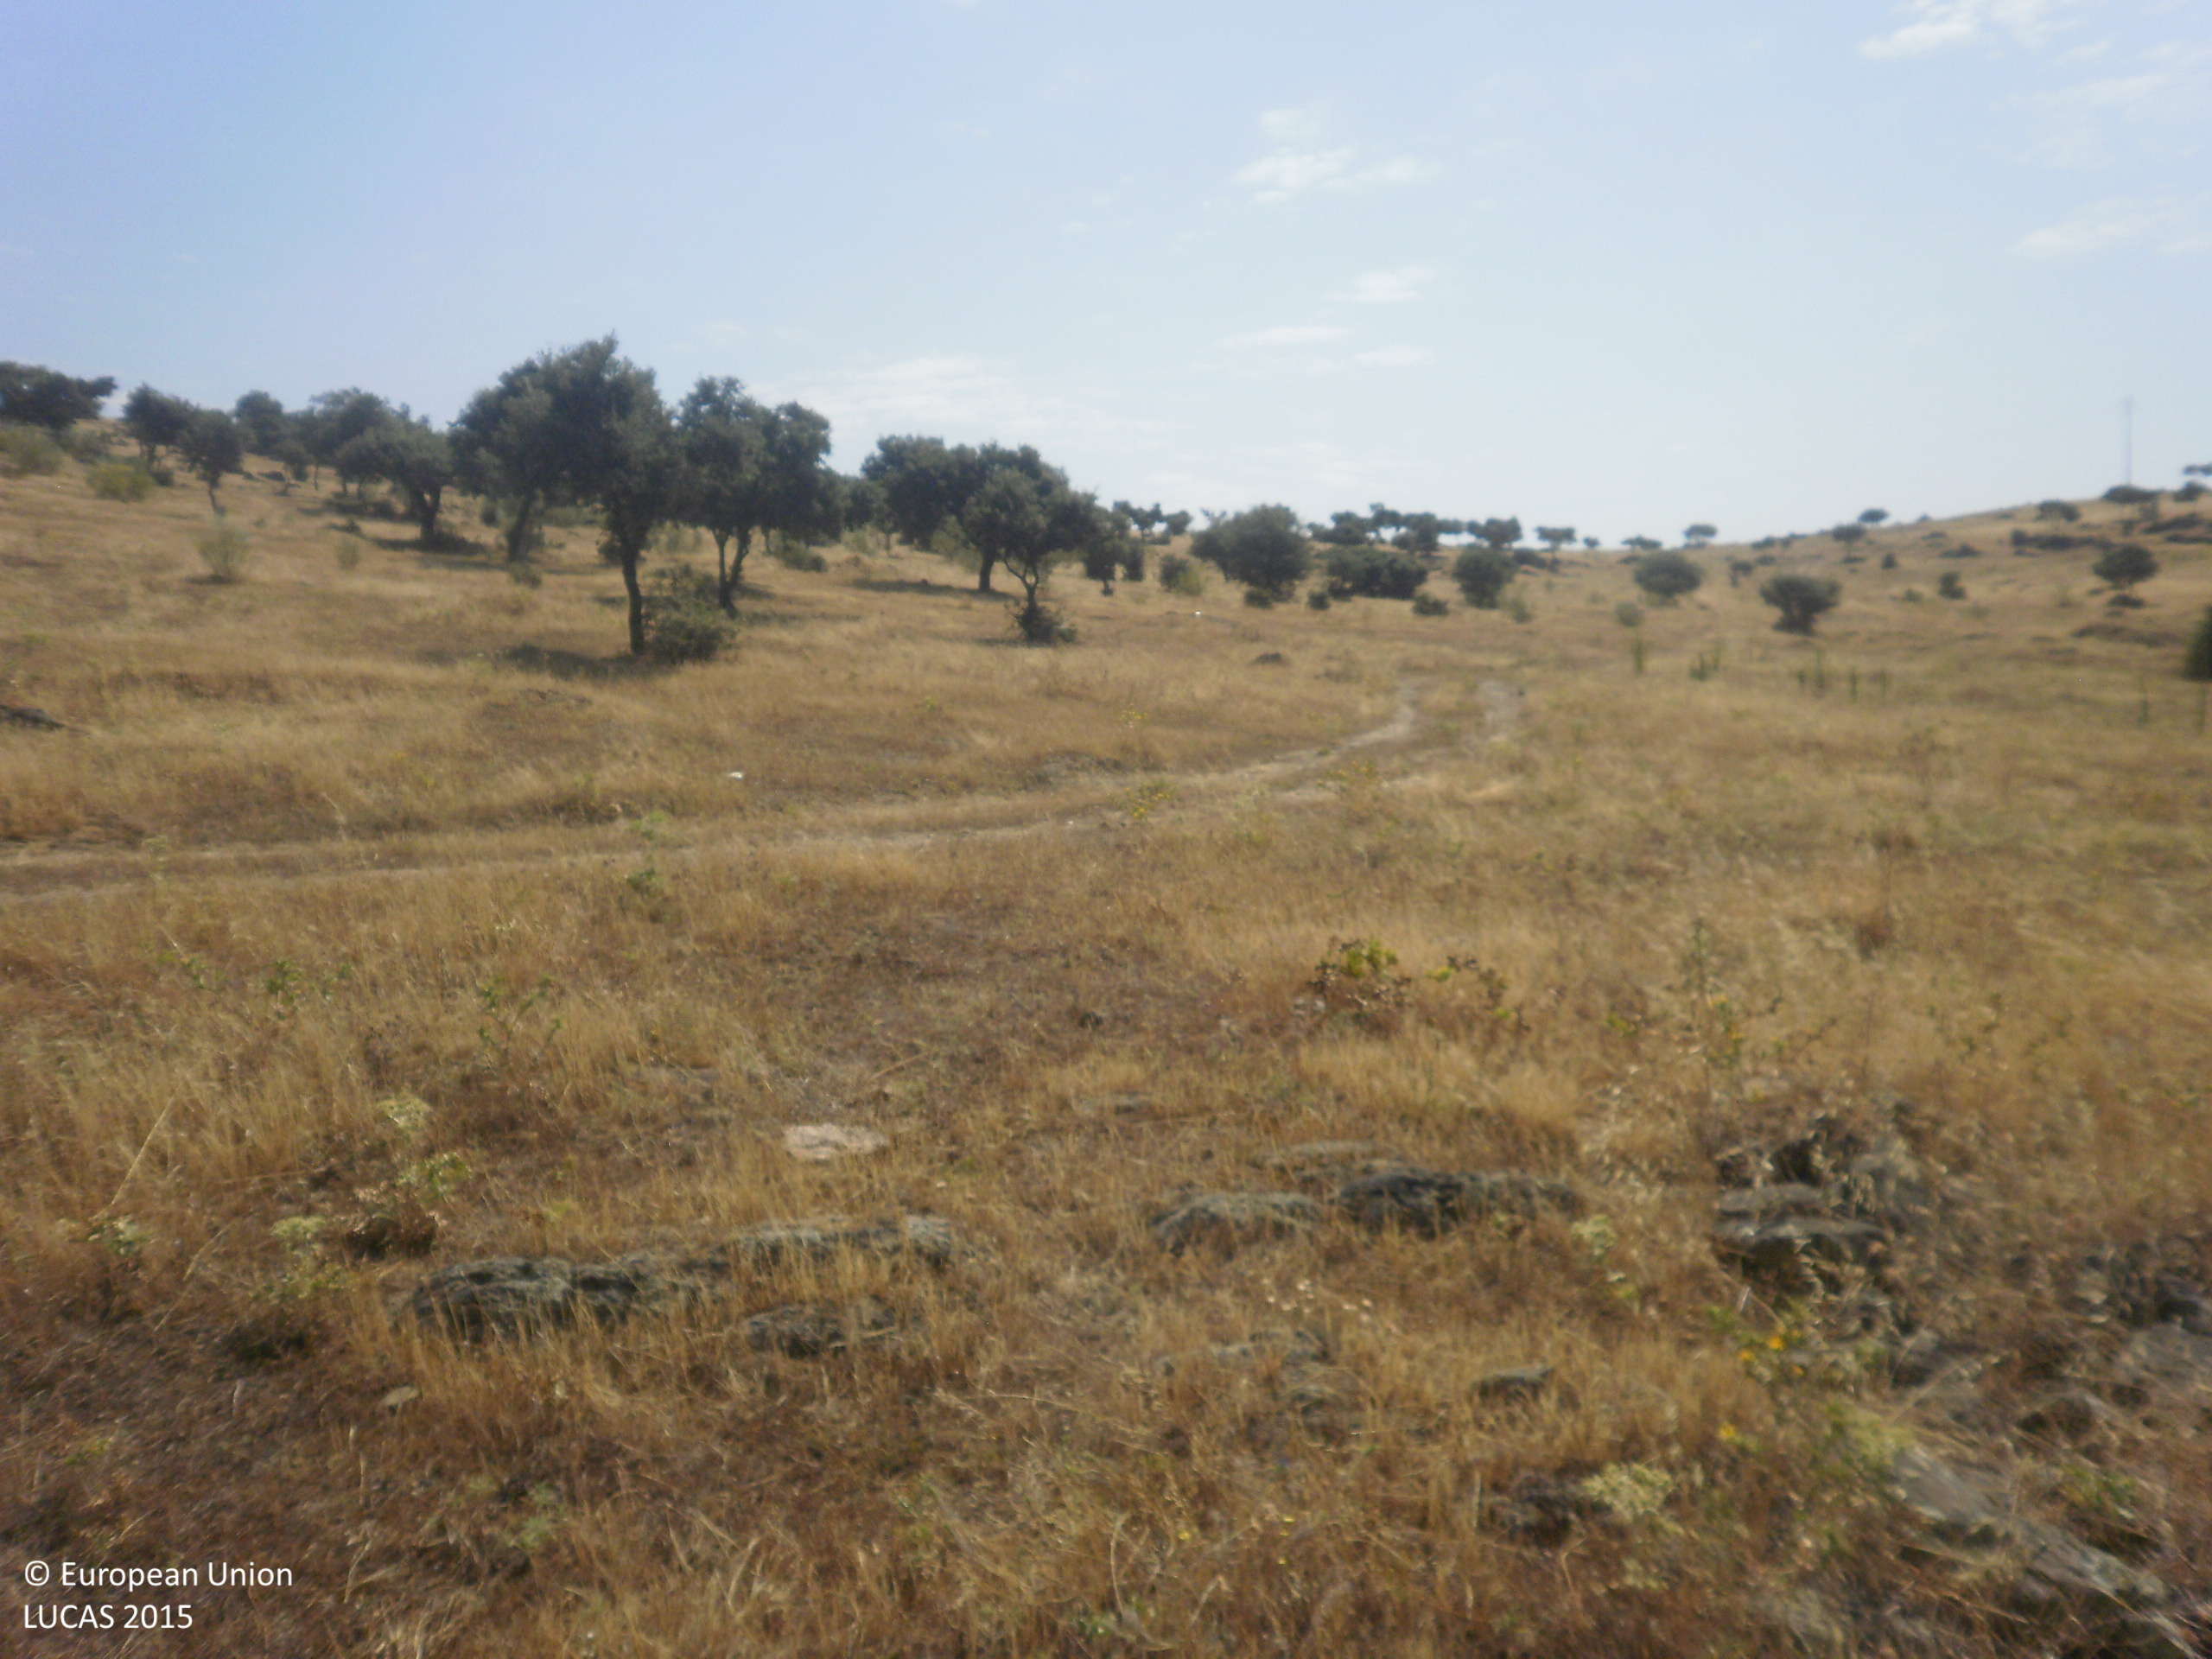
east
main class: Grassland
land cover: Grassland with sparse tree/shrub cover
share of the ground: > 75 %
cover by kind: herbaceous plants 90 %, broadleaved forest trees 5 %, shrubs 5 %
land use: Agriculture (excluding fallow land and kitchen gardens)
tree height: > 5 m
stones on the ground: < 10 %
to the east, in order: Grassland with sparse tree/shrub cover; Tracks; Grassland with sparse tree/shrub cover; Shrubland with sparse tree cover
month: June
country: ES
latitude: 39.1679
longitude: -5.8750
